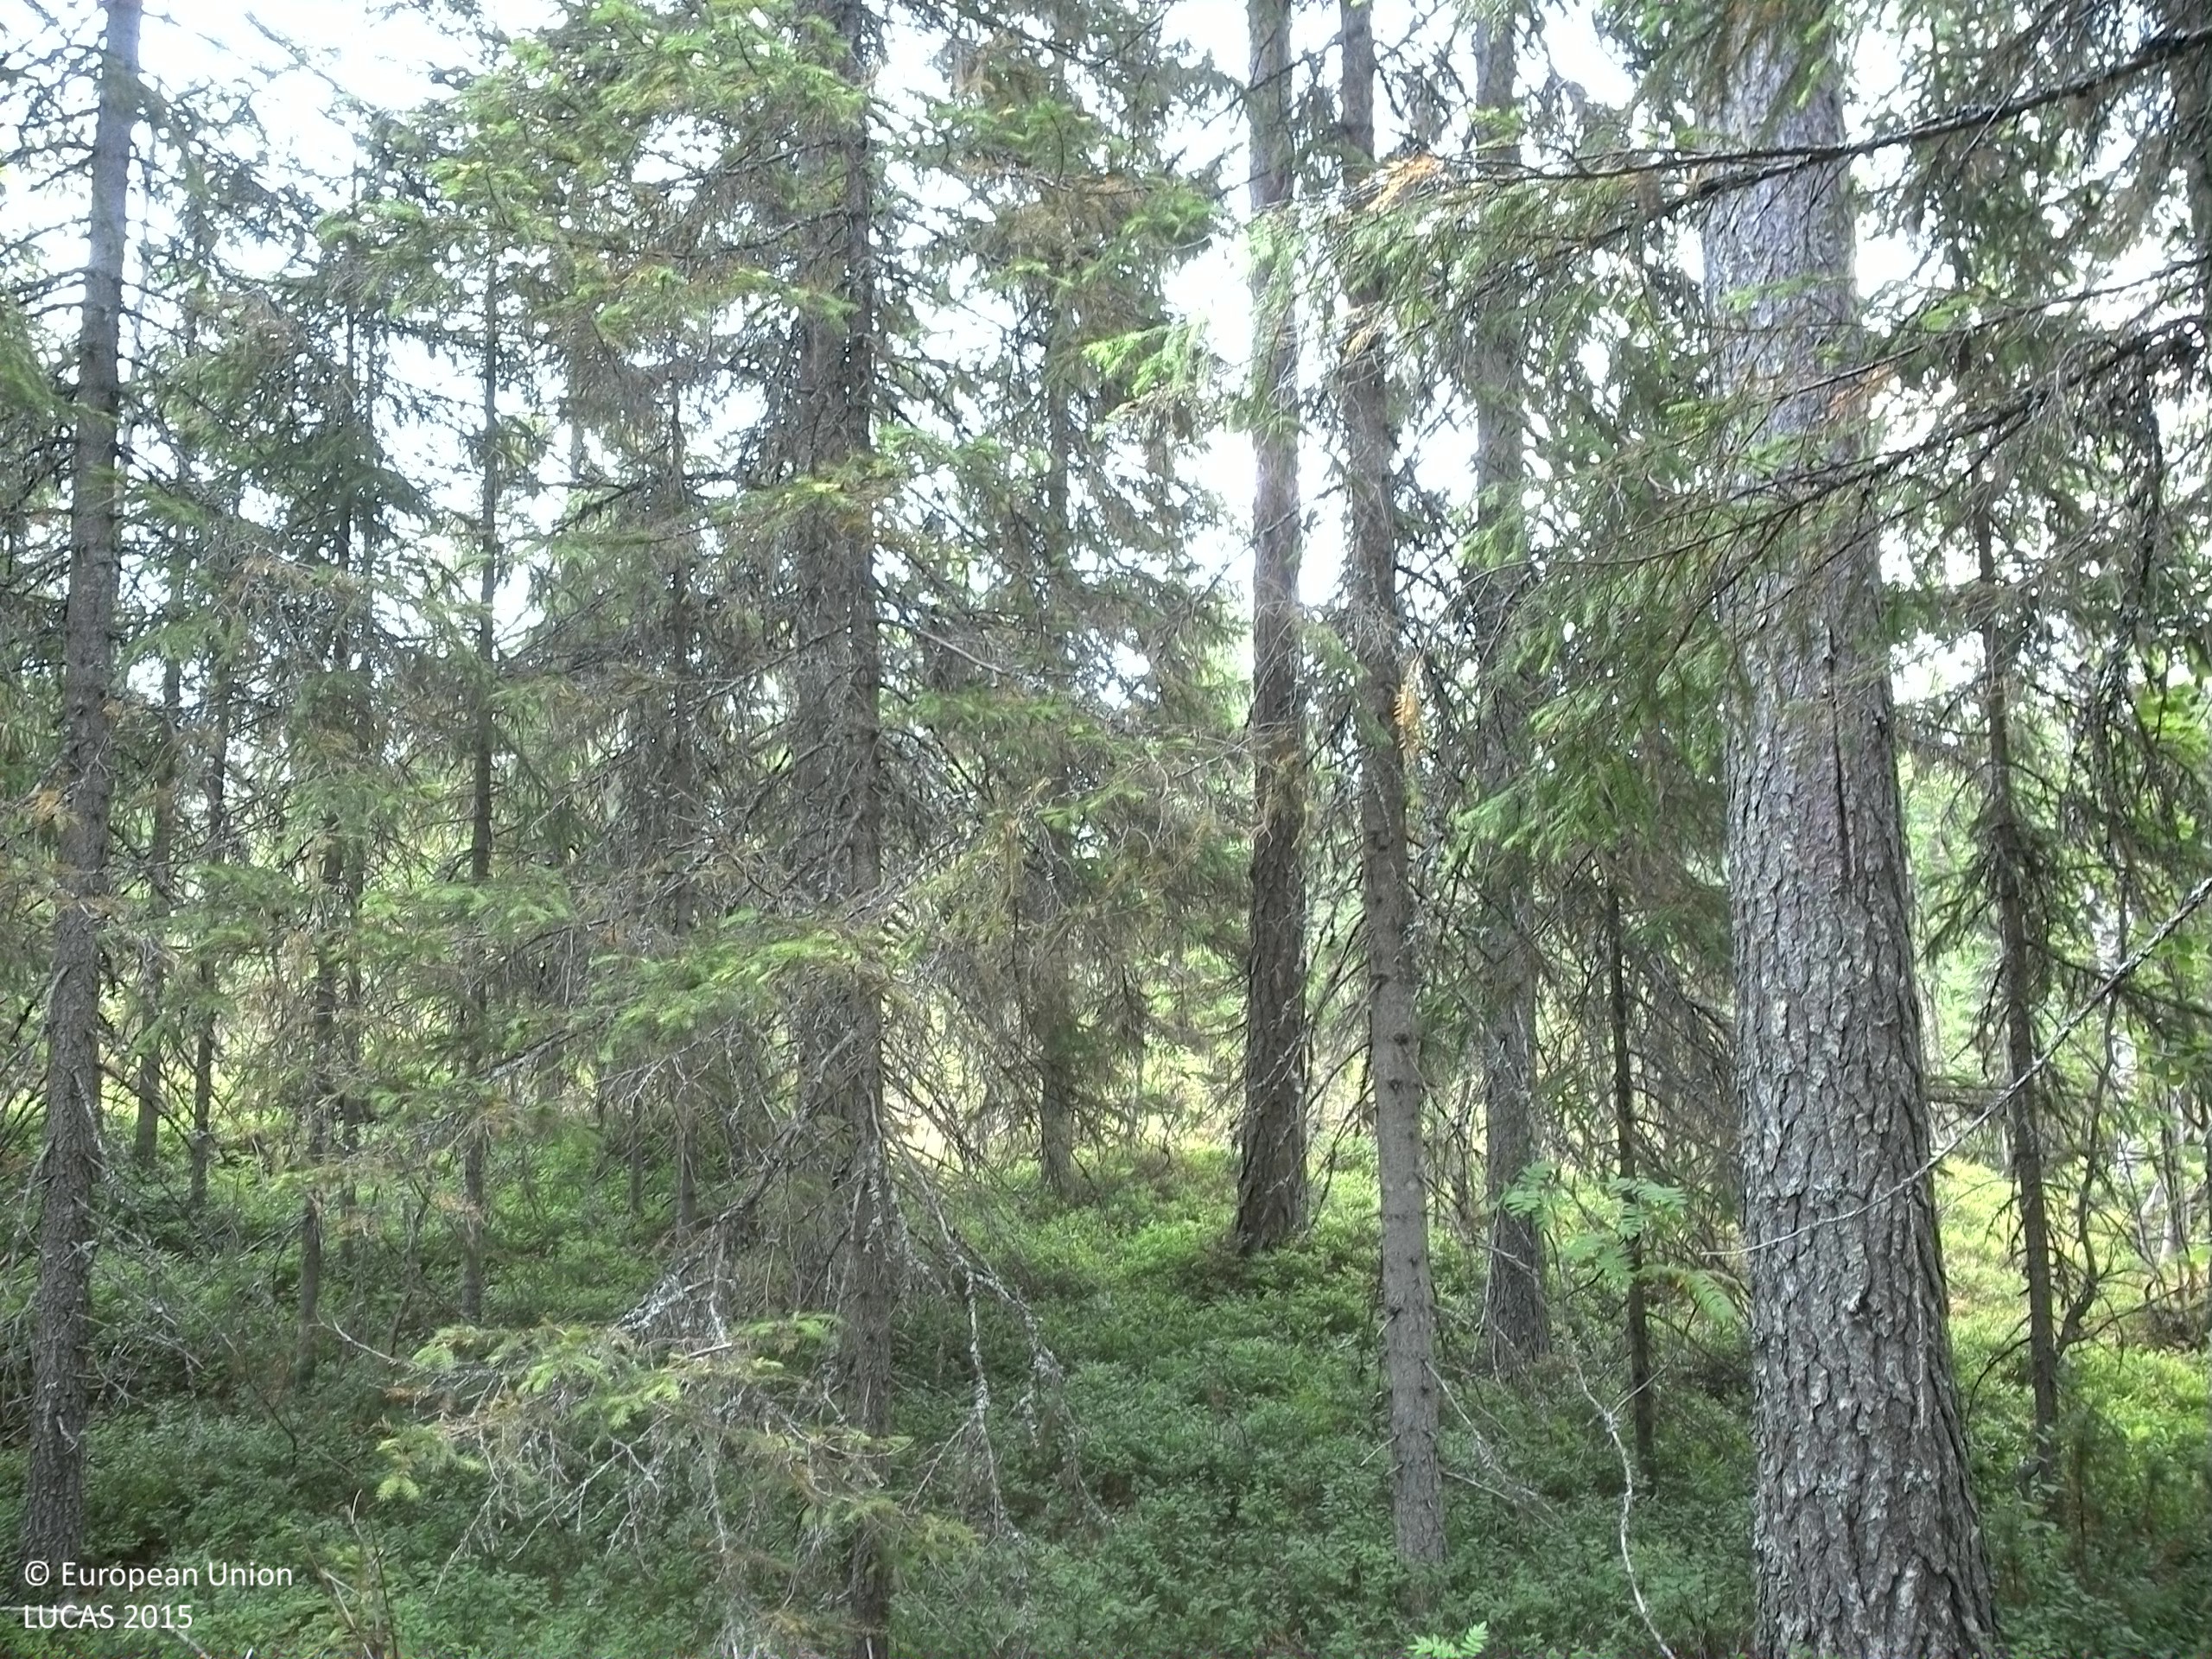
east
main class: Woodland
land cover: Spruce dominated coniferous woodland
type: boreal forest
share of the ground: > 75 %
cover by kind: coniferous forest trees 75 %, shrubs 20 %, lichens and mosses 5 %
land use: Forestry
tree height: > 5 m
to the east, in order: Spruce dominated coniferous woodland; Pine dominated mixed woodland; Spruce dominated coniferous woodland; Rivers and streams; Spruce dominated coniferous woodland; Spruce dominated mixed woodland; Paved roads, cycling and walking lanes; Ditches and canals; Pine dominated mixed woodland
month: August
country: SE
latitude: 63.7929
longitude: 17.3393
